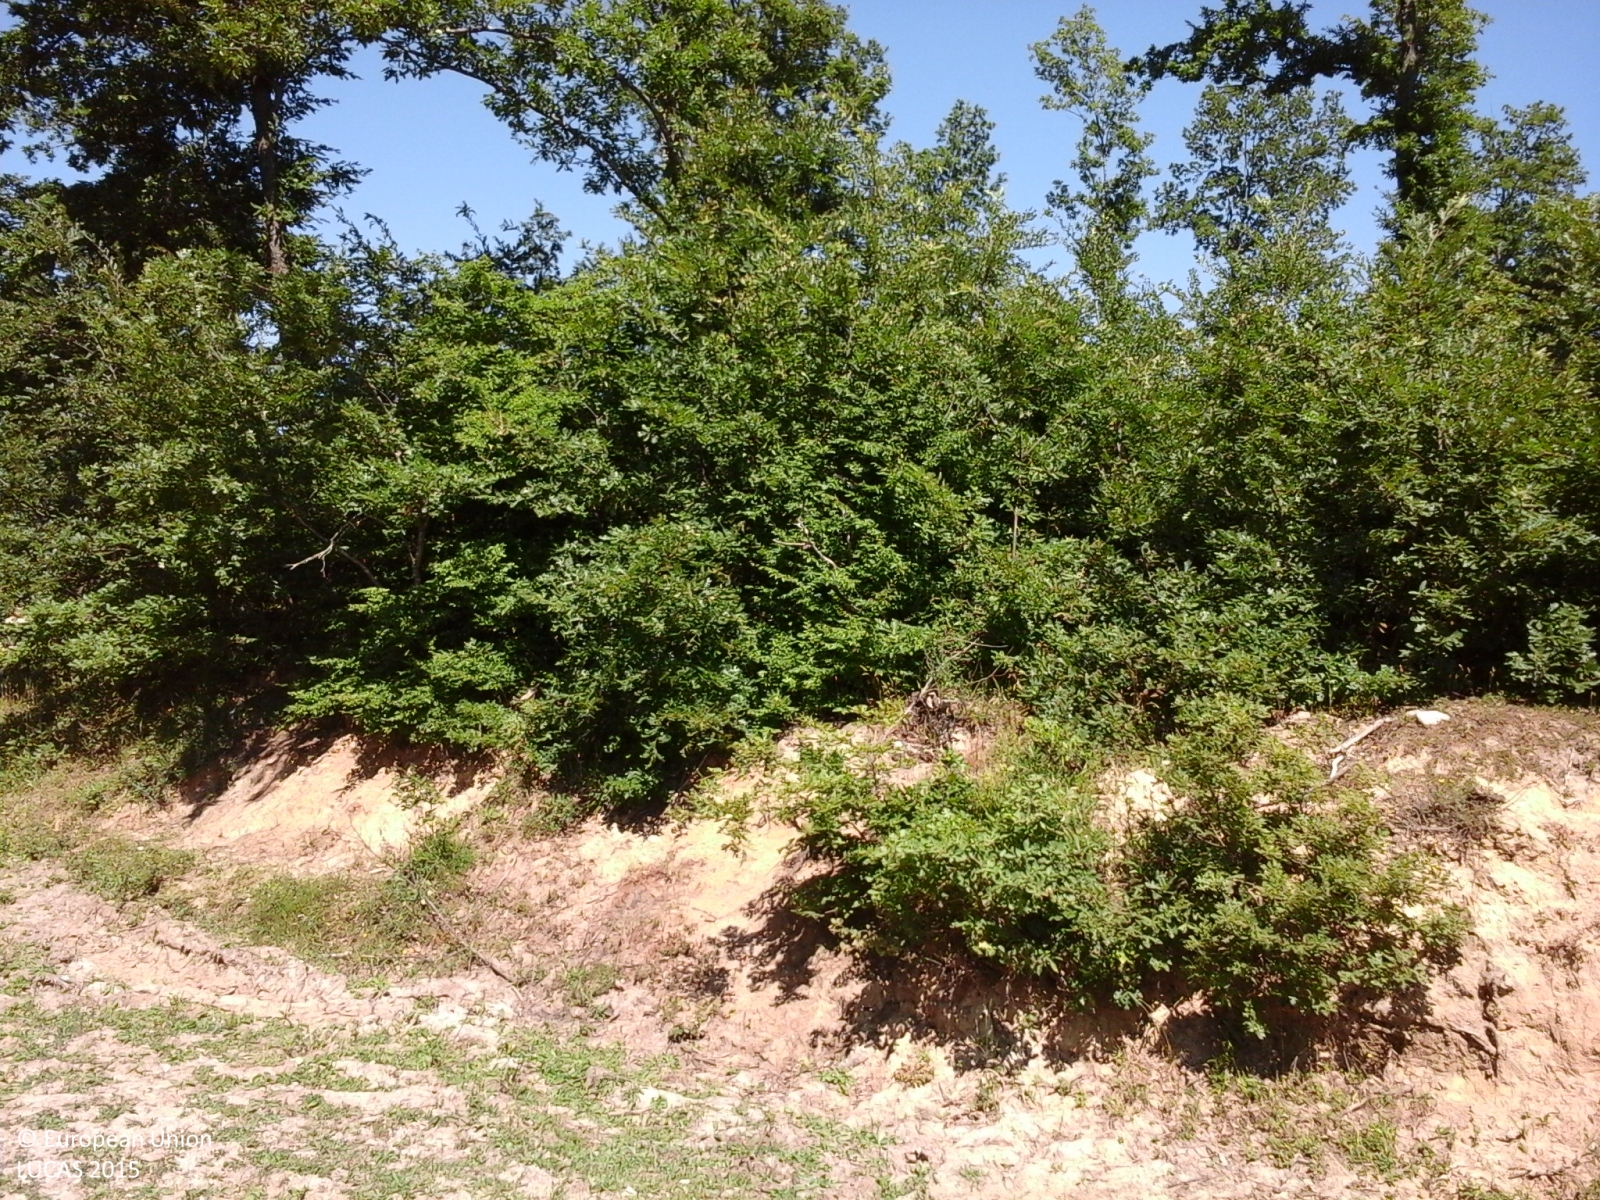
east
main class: Woodland
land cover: Broadleaved woodland
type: thermophilous deciduous forest
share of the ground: > 75 %
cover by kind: broadleaved forest trees 100 %
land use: Forestry
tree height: > 5 m
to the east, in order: Broadleaved woodland
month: July
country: IT
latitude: 41.6570
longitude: 14.7273
